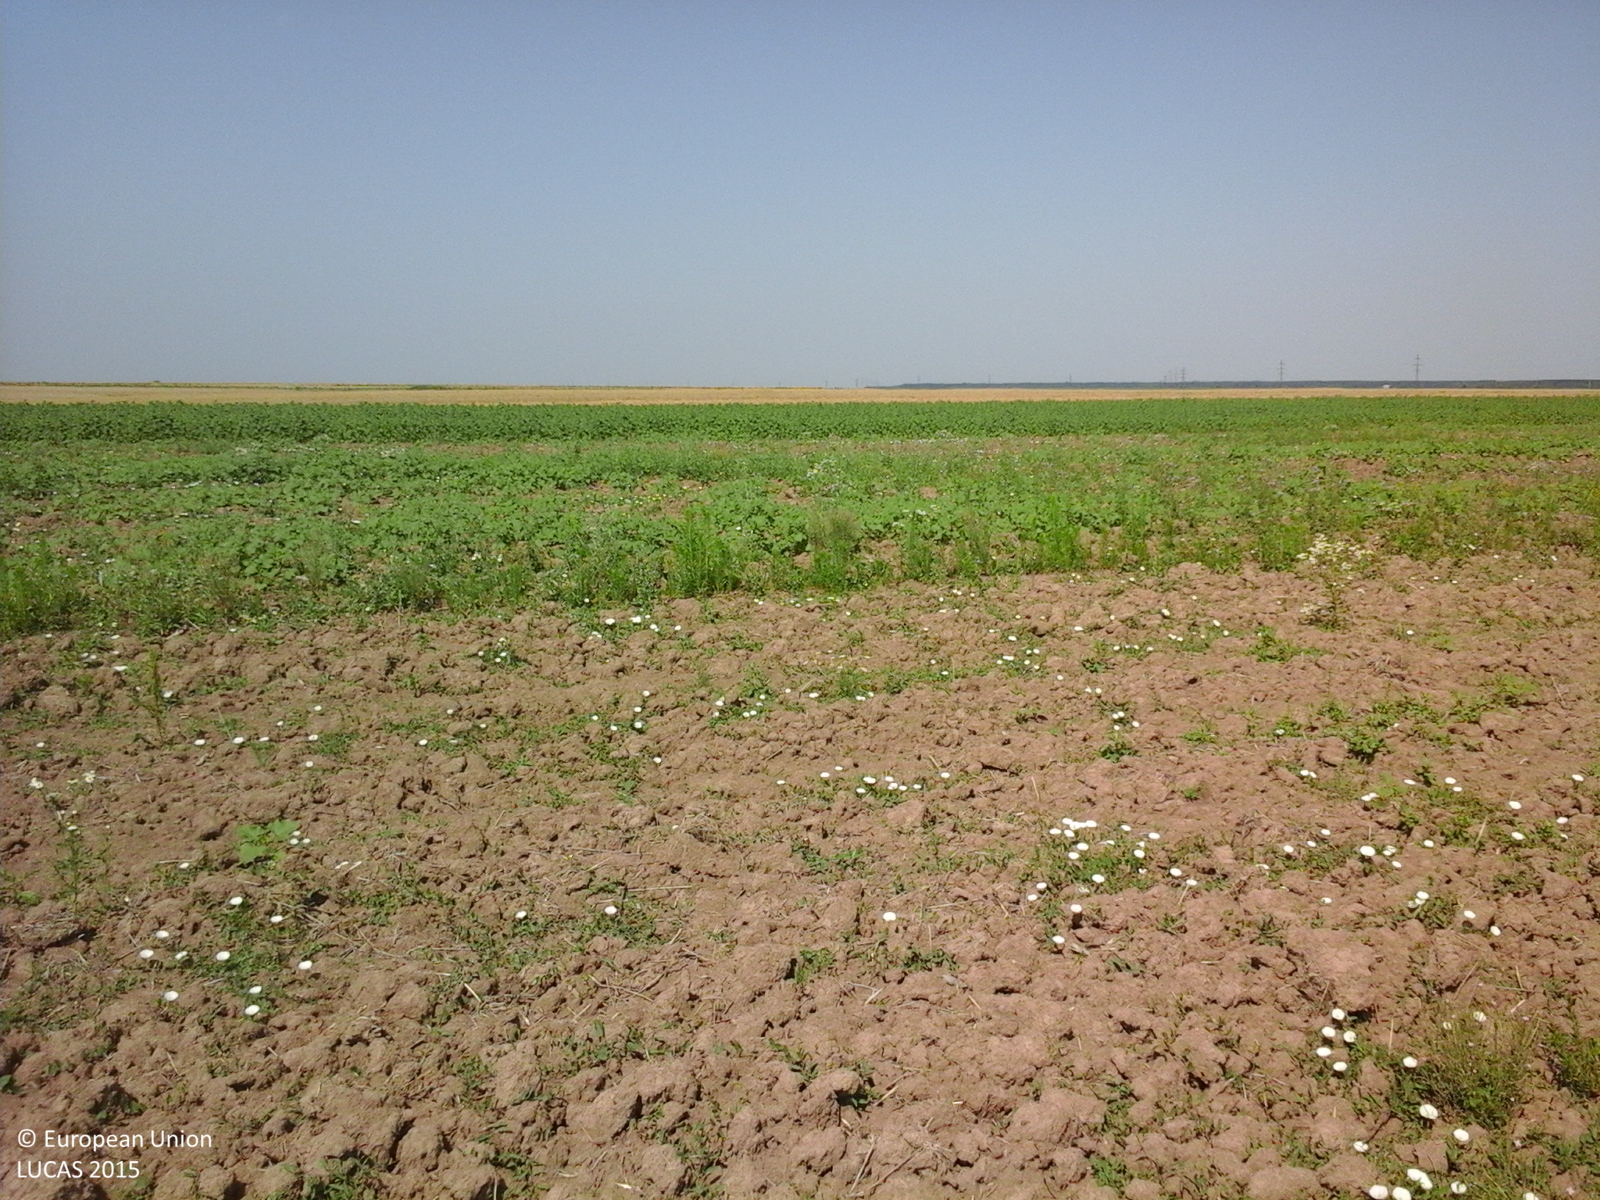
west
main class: Cropland
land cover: Durum wheat
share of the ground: < 10 %
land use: Agriculture (excluding fallow land and kitchen gardens)
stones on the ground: < 10 %
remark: Harvested field
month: July
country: RO
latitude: 44.4183
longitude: 25.2960
